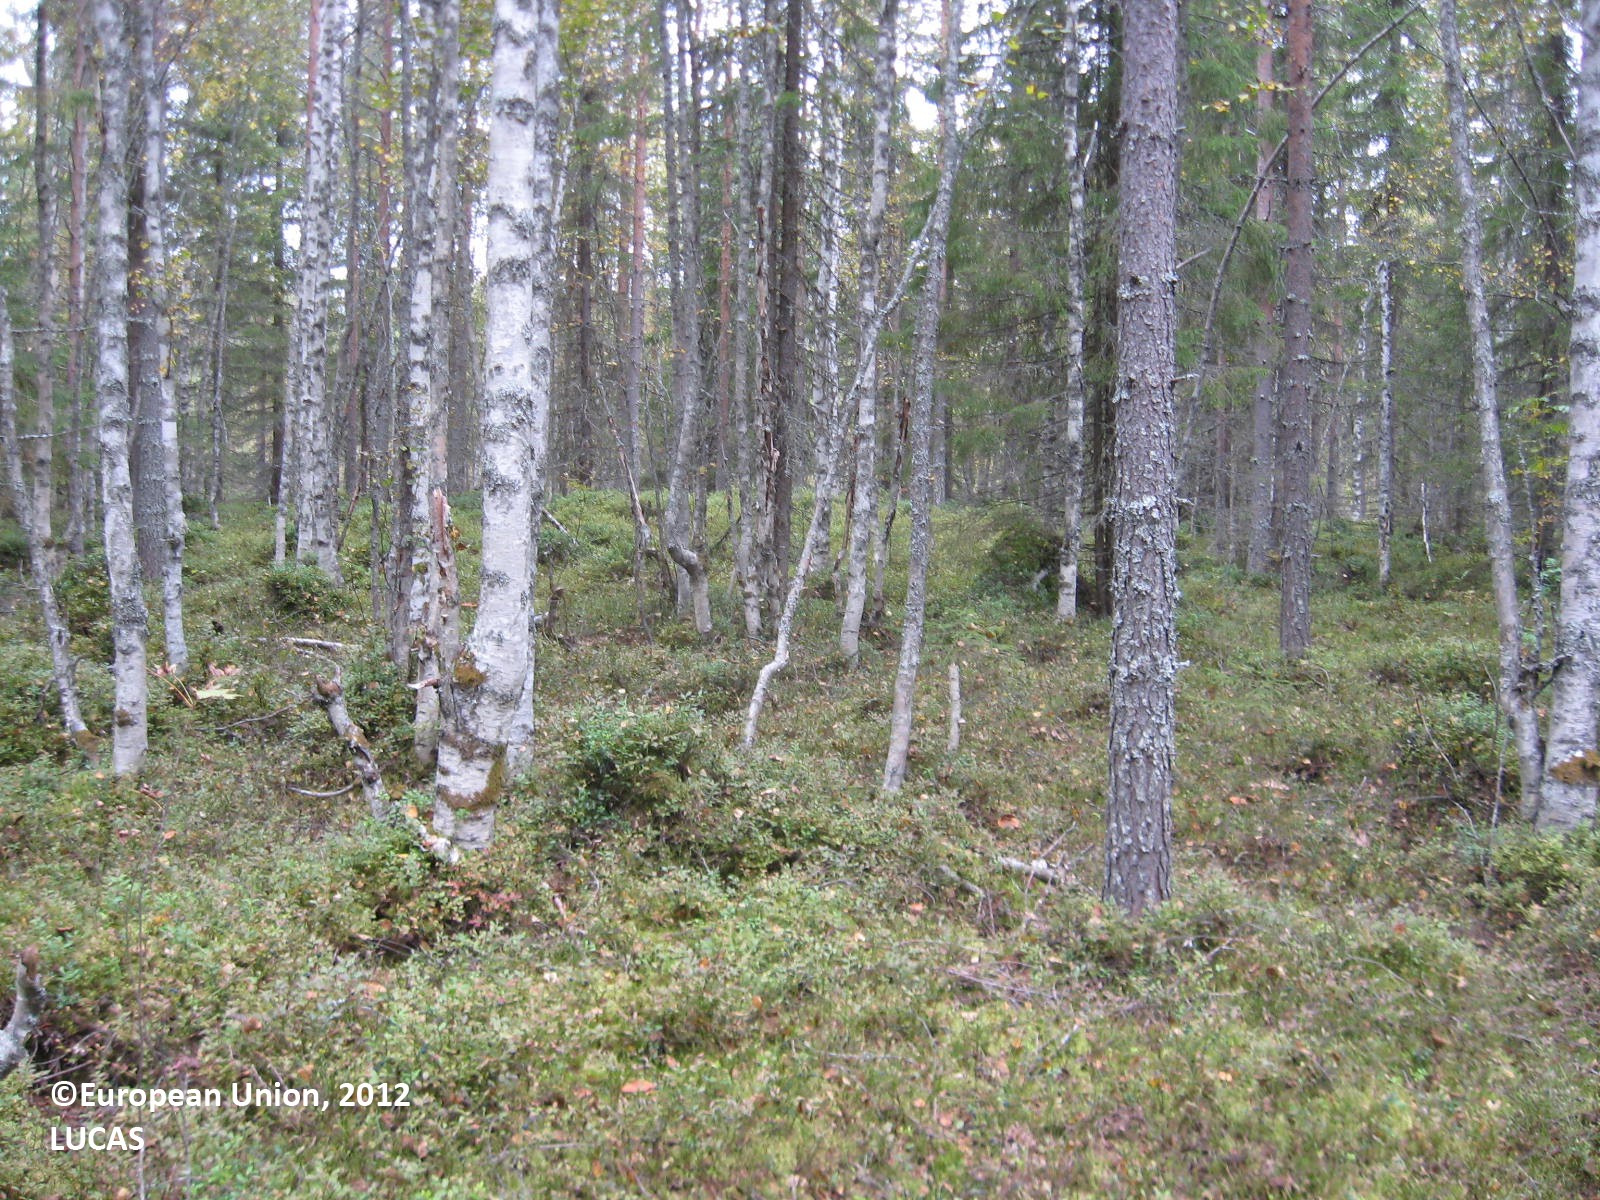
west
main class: Woodland
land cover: Spruce dominated mixed woodland
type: boreal forest
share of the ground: > 75 %
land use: Forestry
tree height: > 5 m
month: August
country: FI
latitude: 63.9313
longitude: 29.2405
